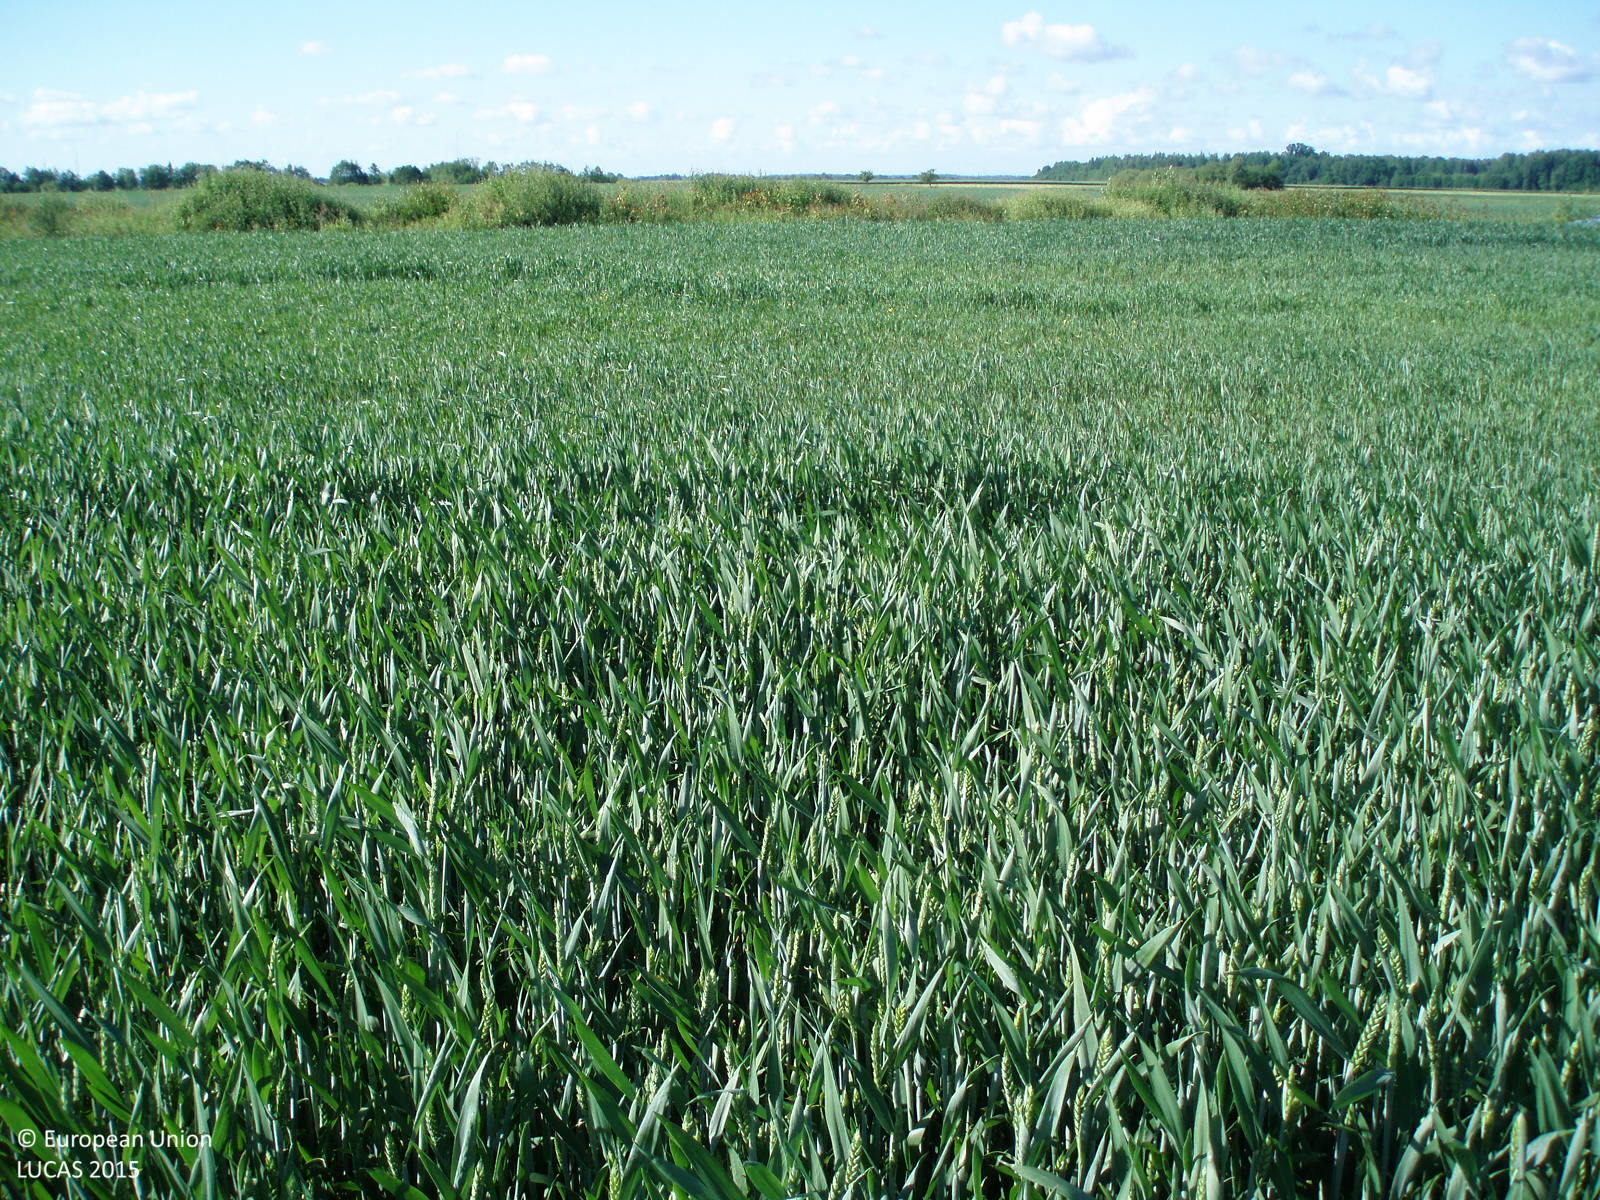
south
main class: Cropland
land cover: Common wheat
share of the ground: > 75 %
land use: Agriculture (excluding fallow land and kitchen gardens)
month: June
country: LT
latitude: 55.1994
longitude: 22.7769
